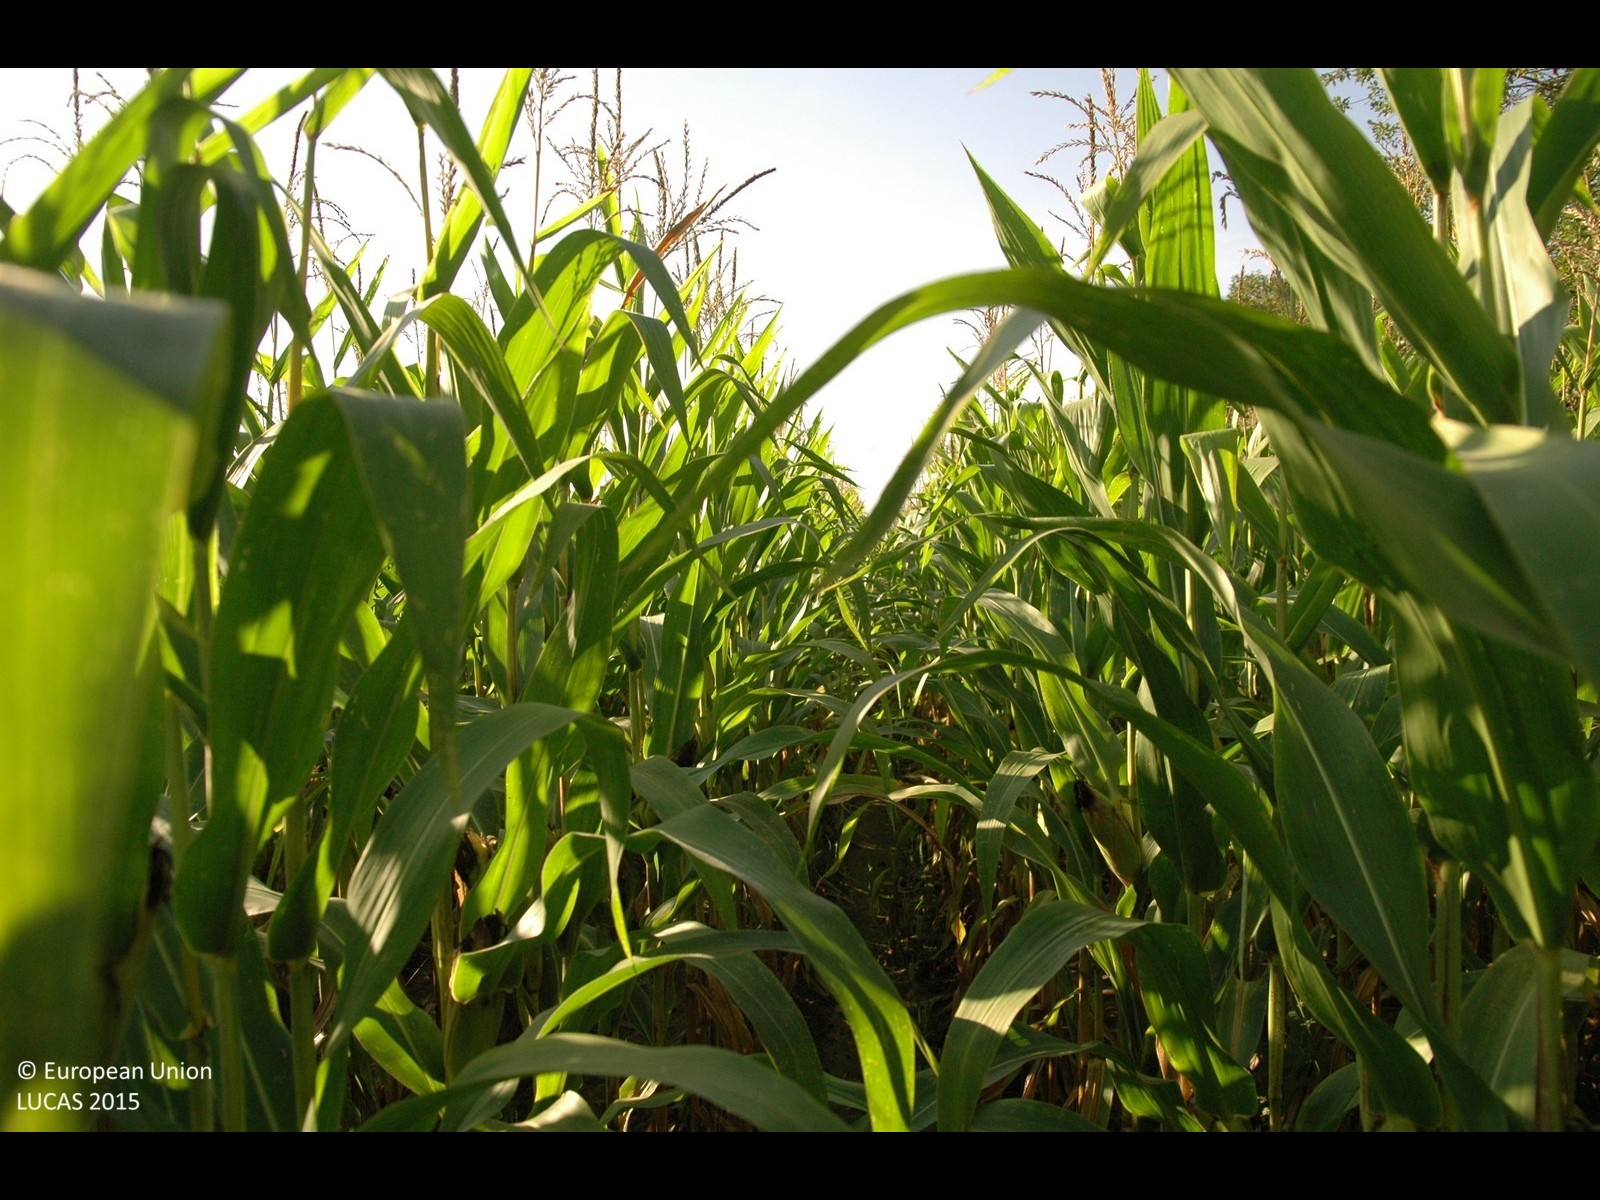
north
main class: Cropland
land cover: Maize
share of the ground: > 75 %
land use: Agriculture (excluding fallow land and kitchen gardens)
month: August
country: HR
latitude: 46.1087
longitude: 16.9231
